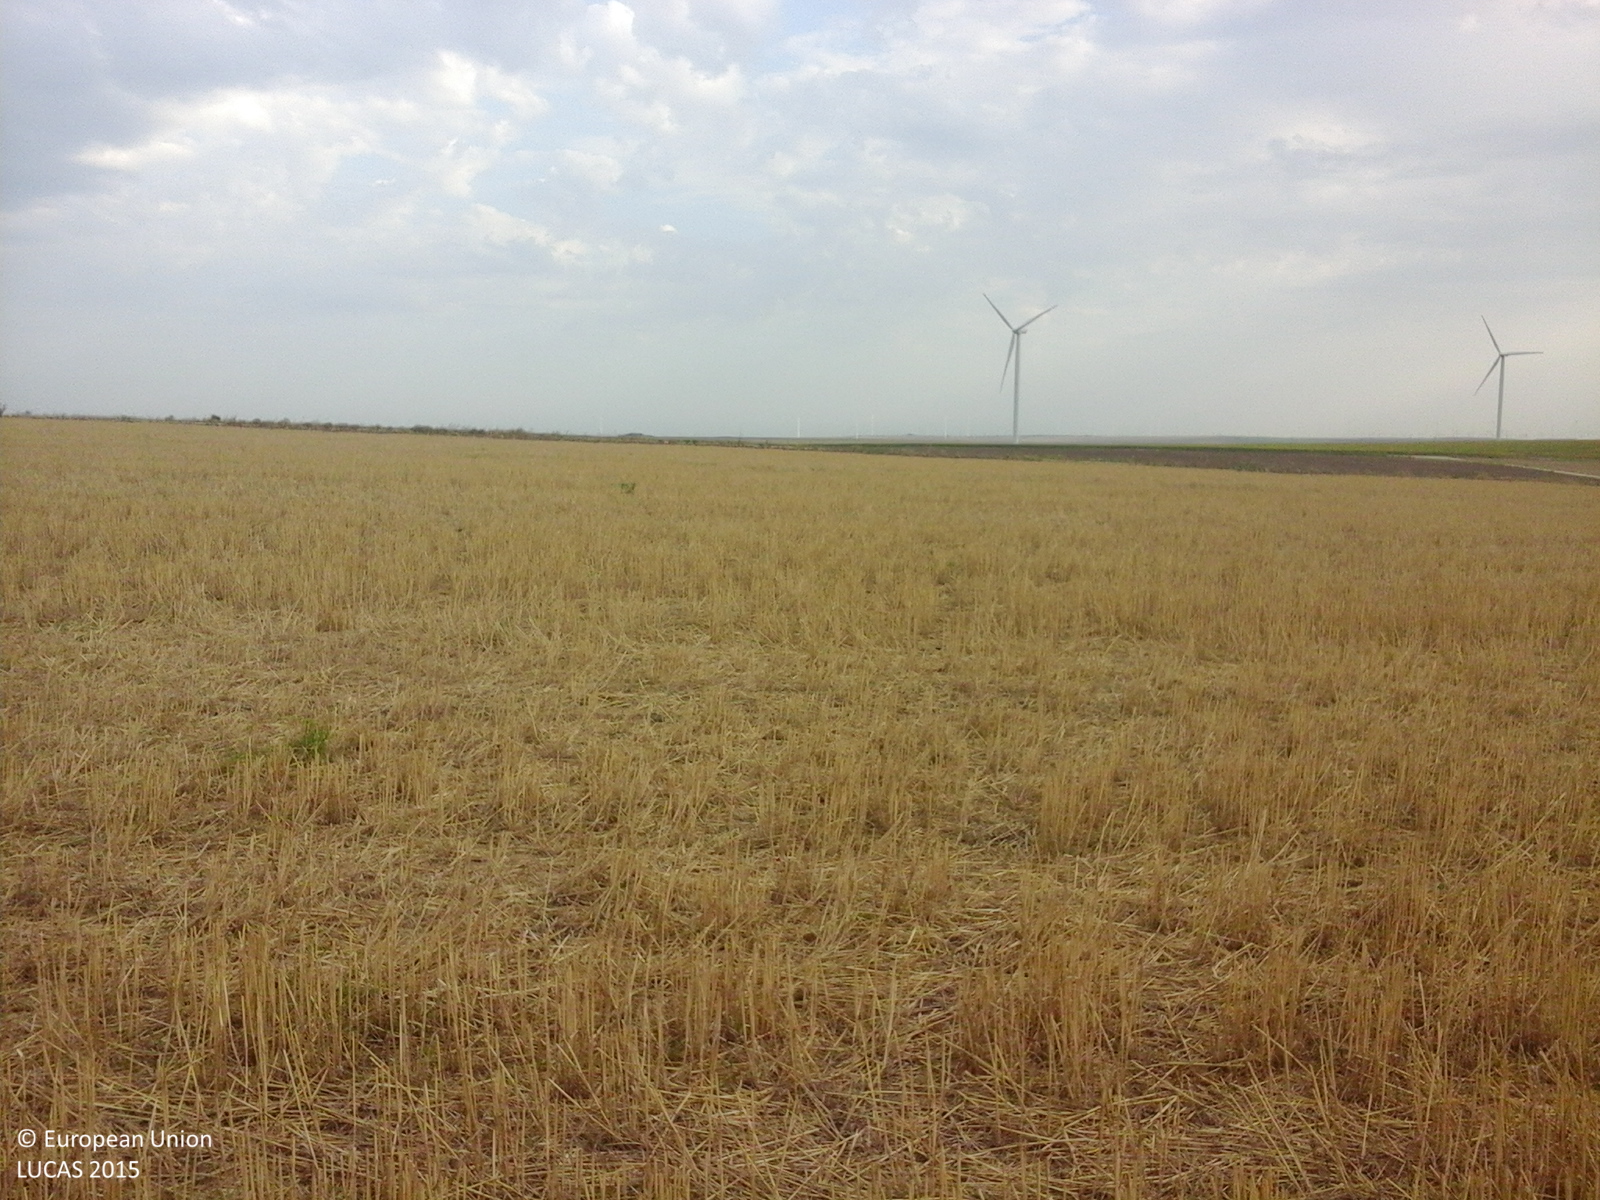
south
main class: Cropland
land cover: Common wheat
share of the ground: > 75 %
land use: Agriculture (excluding fallow land and kitchen gardens)
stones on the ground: < 10 %
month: August
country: RO
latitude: 44.3894
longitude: 28.1760
